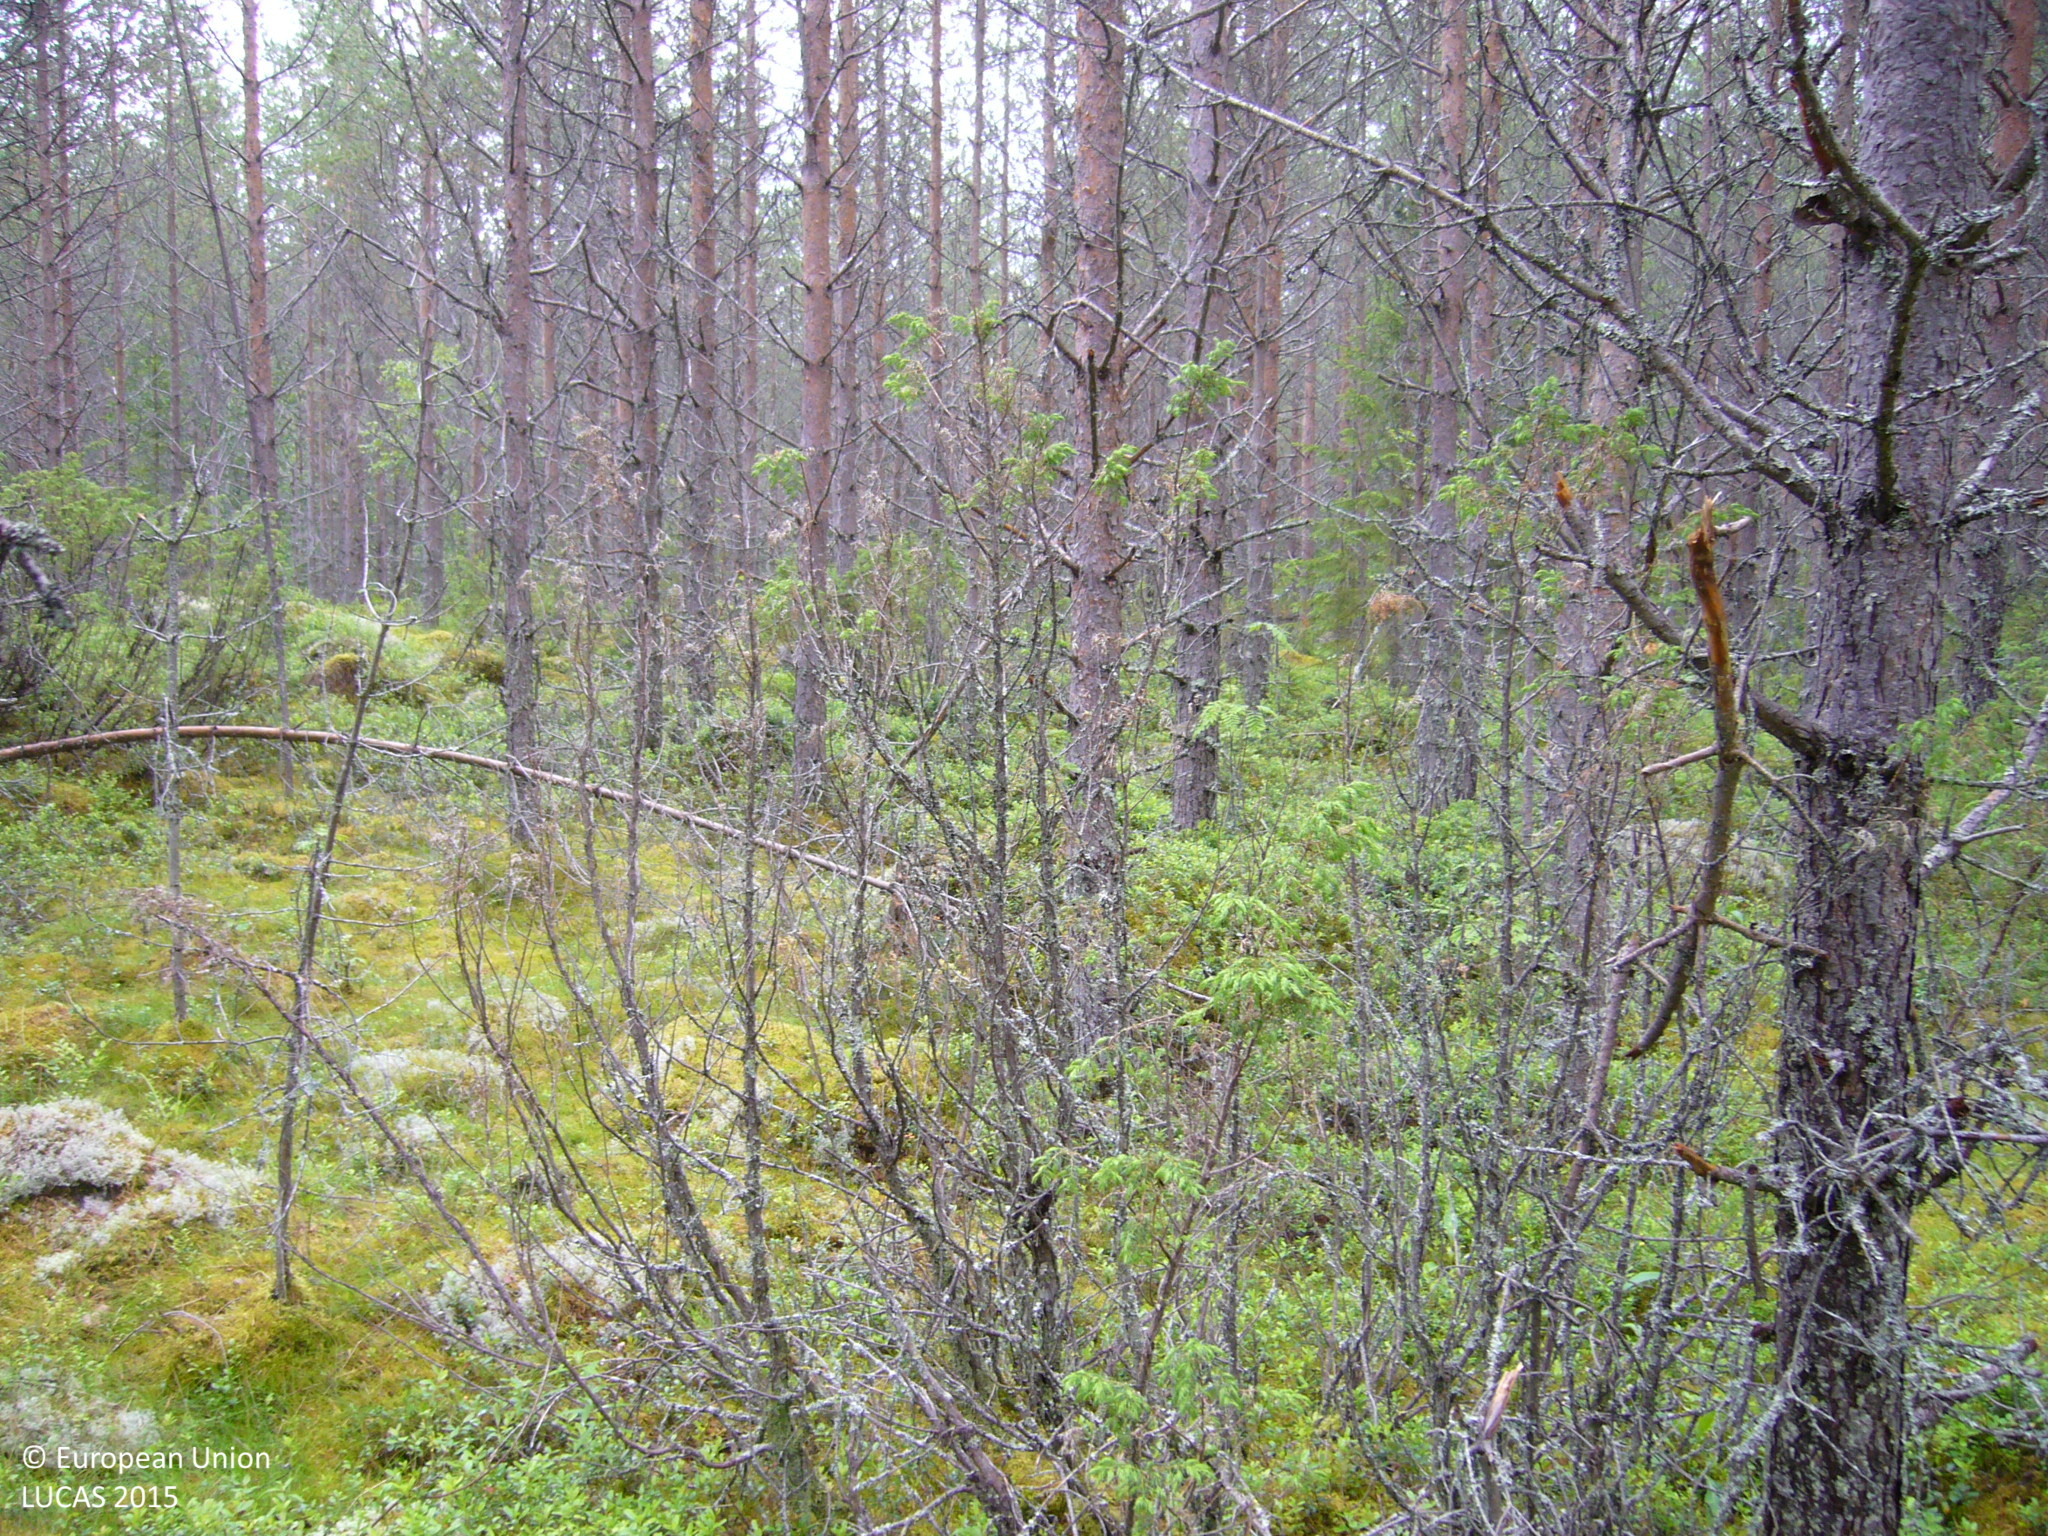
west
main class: Woodland
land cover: Pine dominated coniferous woodland
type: boreal forest
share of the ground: > 75 %
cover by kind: coniferous forest trees 75 %, shrubs 25 %
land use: Forestry
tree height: > 5 m
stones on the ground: > 50 %
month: July
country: FI
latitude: 63.6029
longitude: 25.3997
